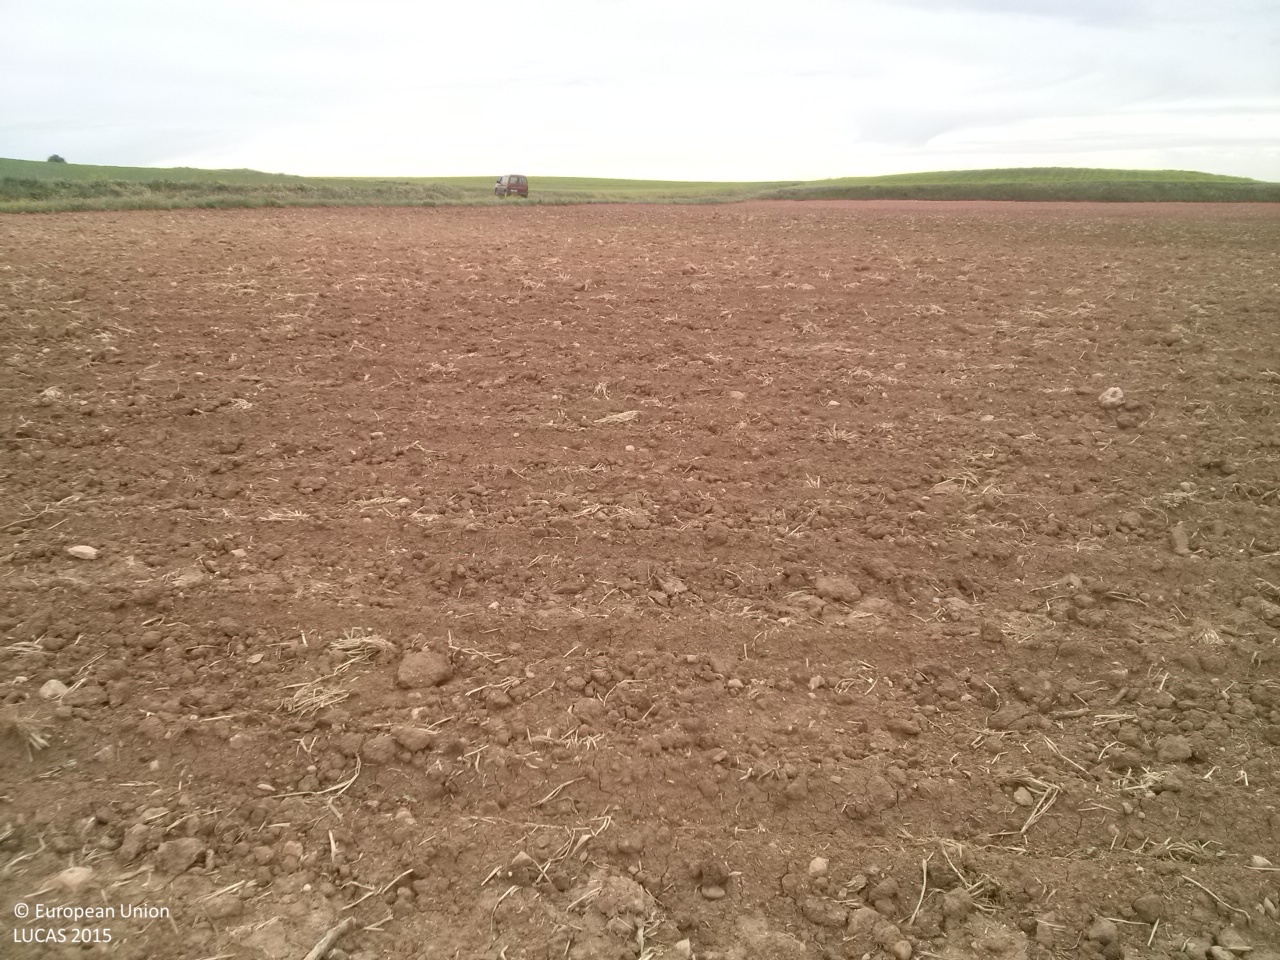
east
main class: Cropland
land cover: Sunflower
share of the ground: < 10 %
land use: Agriculture (excluding fallow land and kitchen gardens)
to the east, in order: Sunflower; Grass margins; Tracks; Grass margins; Dry pulses; Grass margins; Tracks; Grass margins; Barley
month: May
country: ES
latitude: 39.9089
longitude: -2.8769
